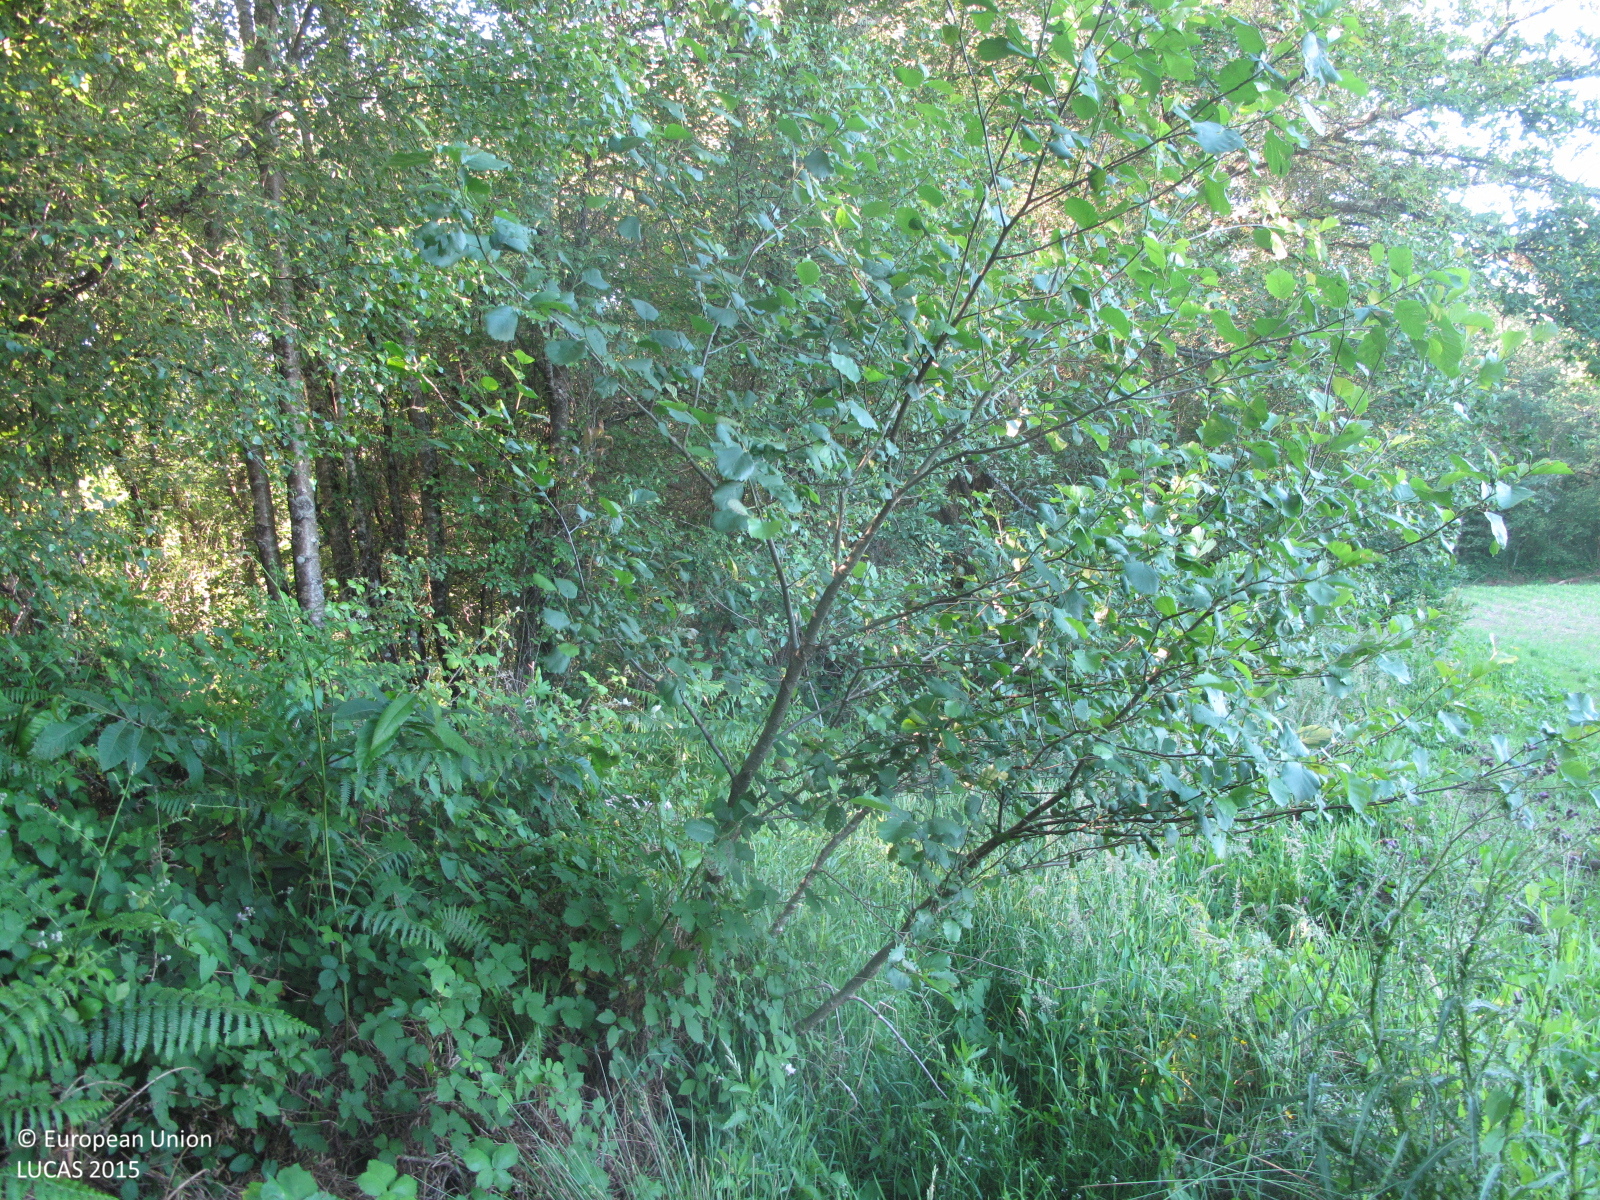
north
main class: Woodland
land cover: Broadleaved woodland
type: non-riverine alder, birch or aspen forest
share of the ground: > 75 %
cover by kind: broadleaved forest trees 90 %, shrubs 10 %
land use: Forestry
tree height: > 5 m
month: June
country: ES
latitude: 43.0069
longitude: -8.5708
